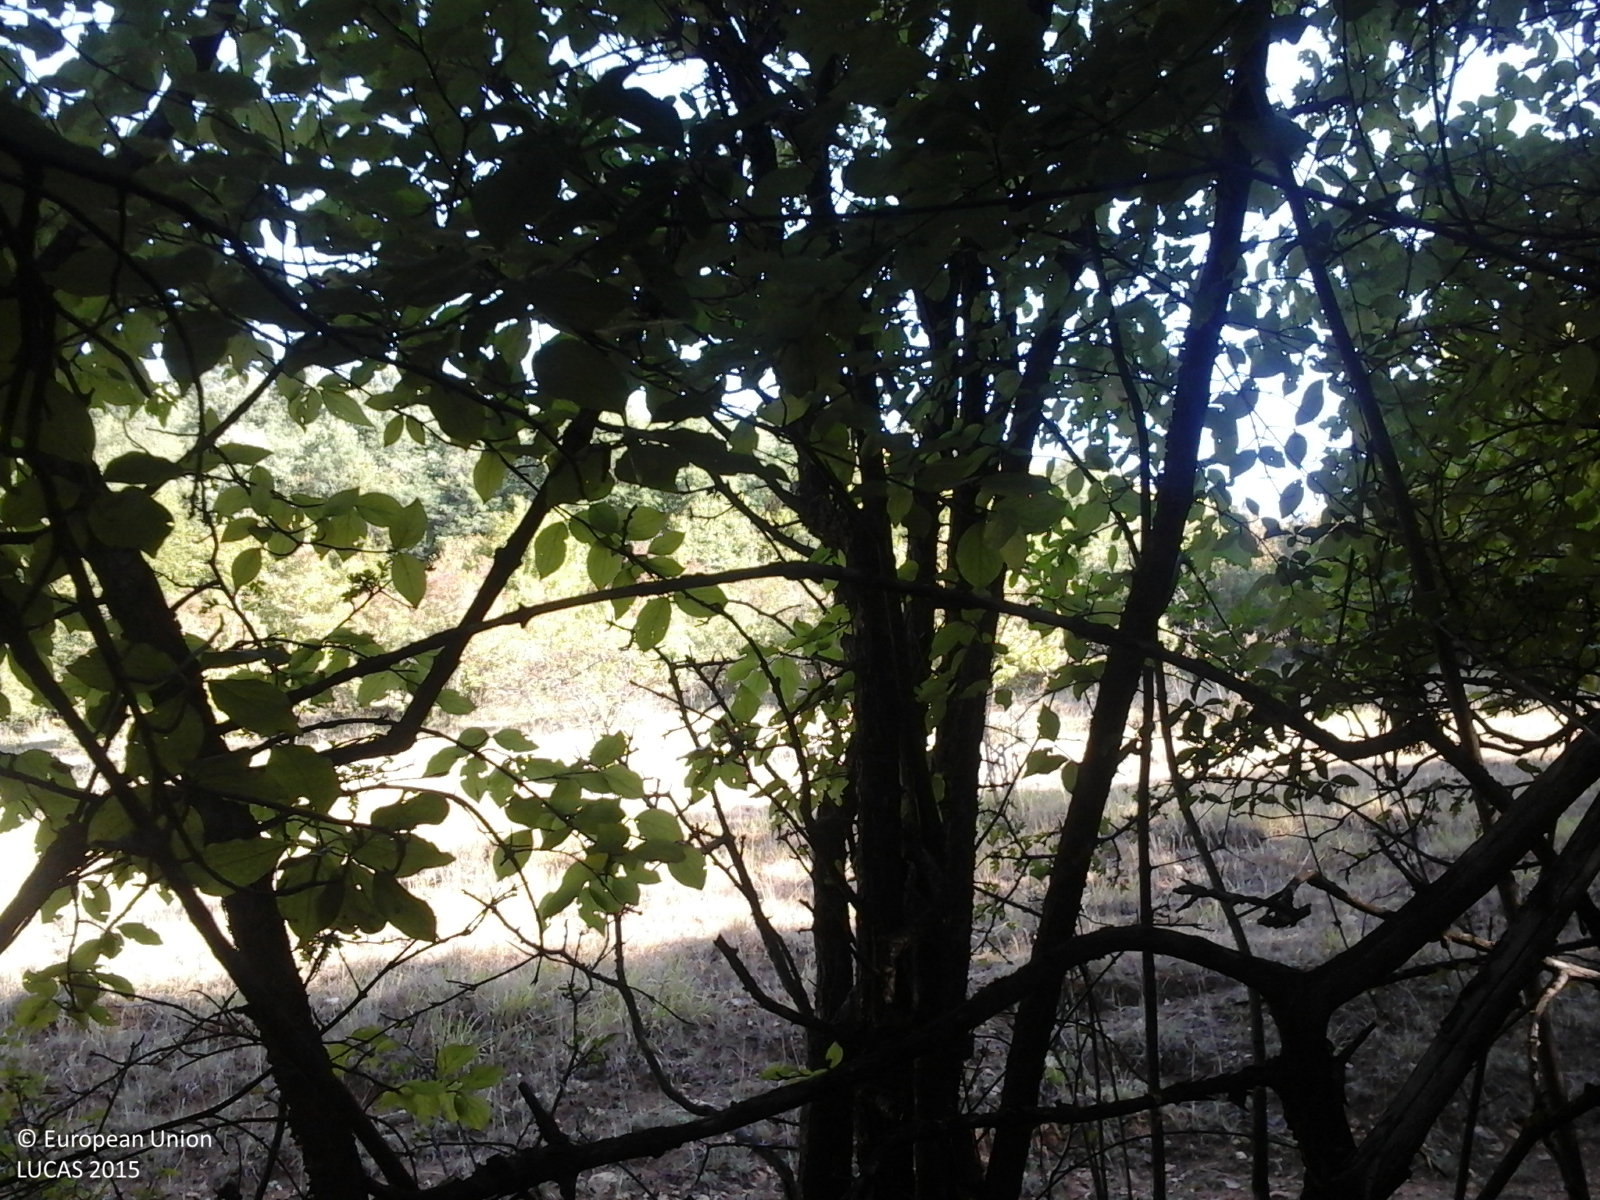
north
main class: Woodland
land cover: Broadleaved woodland
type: beech forest
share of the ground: > 75 %
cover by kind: broadleaved forest trees 100 %
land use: Forestry
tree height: > 5 m
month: September
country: RO
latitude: 47.3638
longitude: 23.4051
